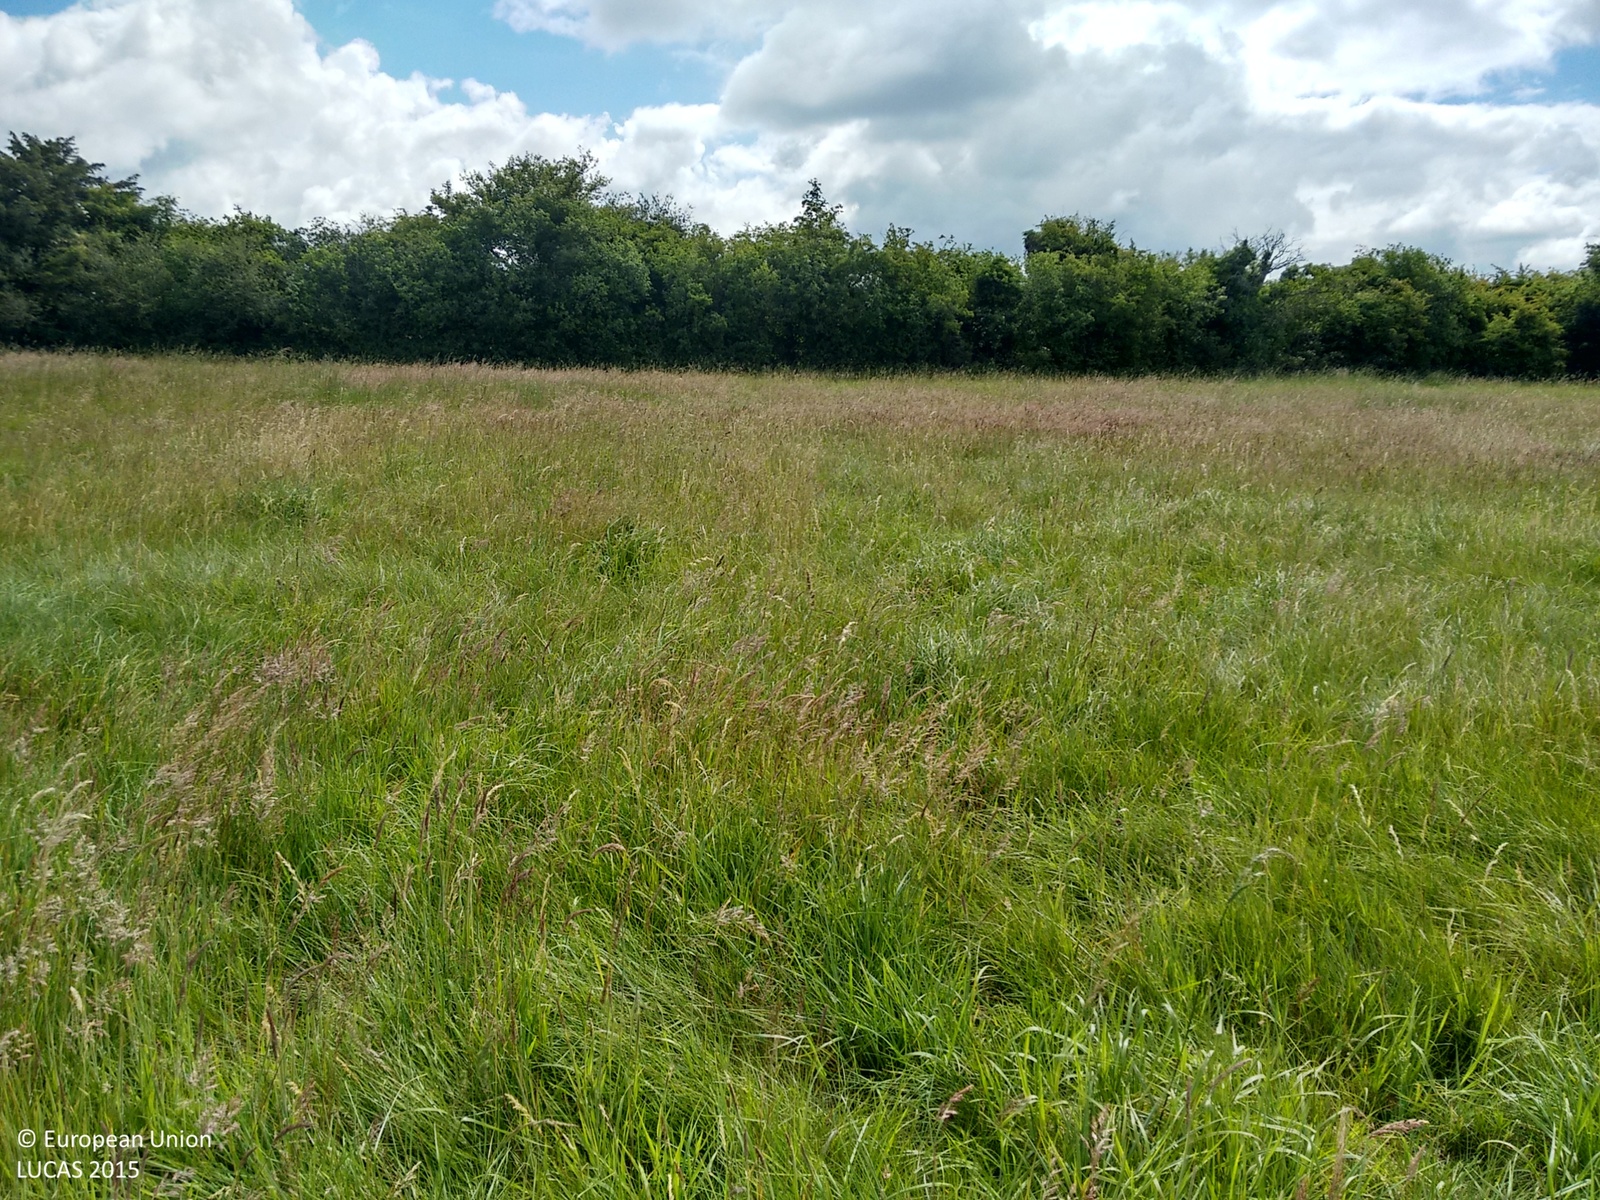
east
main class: Grassland
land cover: Grassland without tree/shrub cover
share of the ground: > 75 %
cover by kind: herbaceous plants 100 %
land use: Agriculture (excluding fallow land and kitchen gardens)
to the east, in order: Grassland without tree/shrub cover; Fences; Managed hedges; Grass margins; Tracks; Grass margins; Managed hedges; Grass margins; Barley
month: June
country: GB
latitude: 51.5220
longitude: -1.5384
